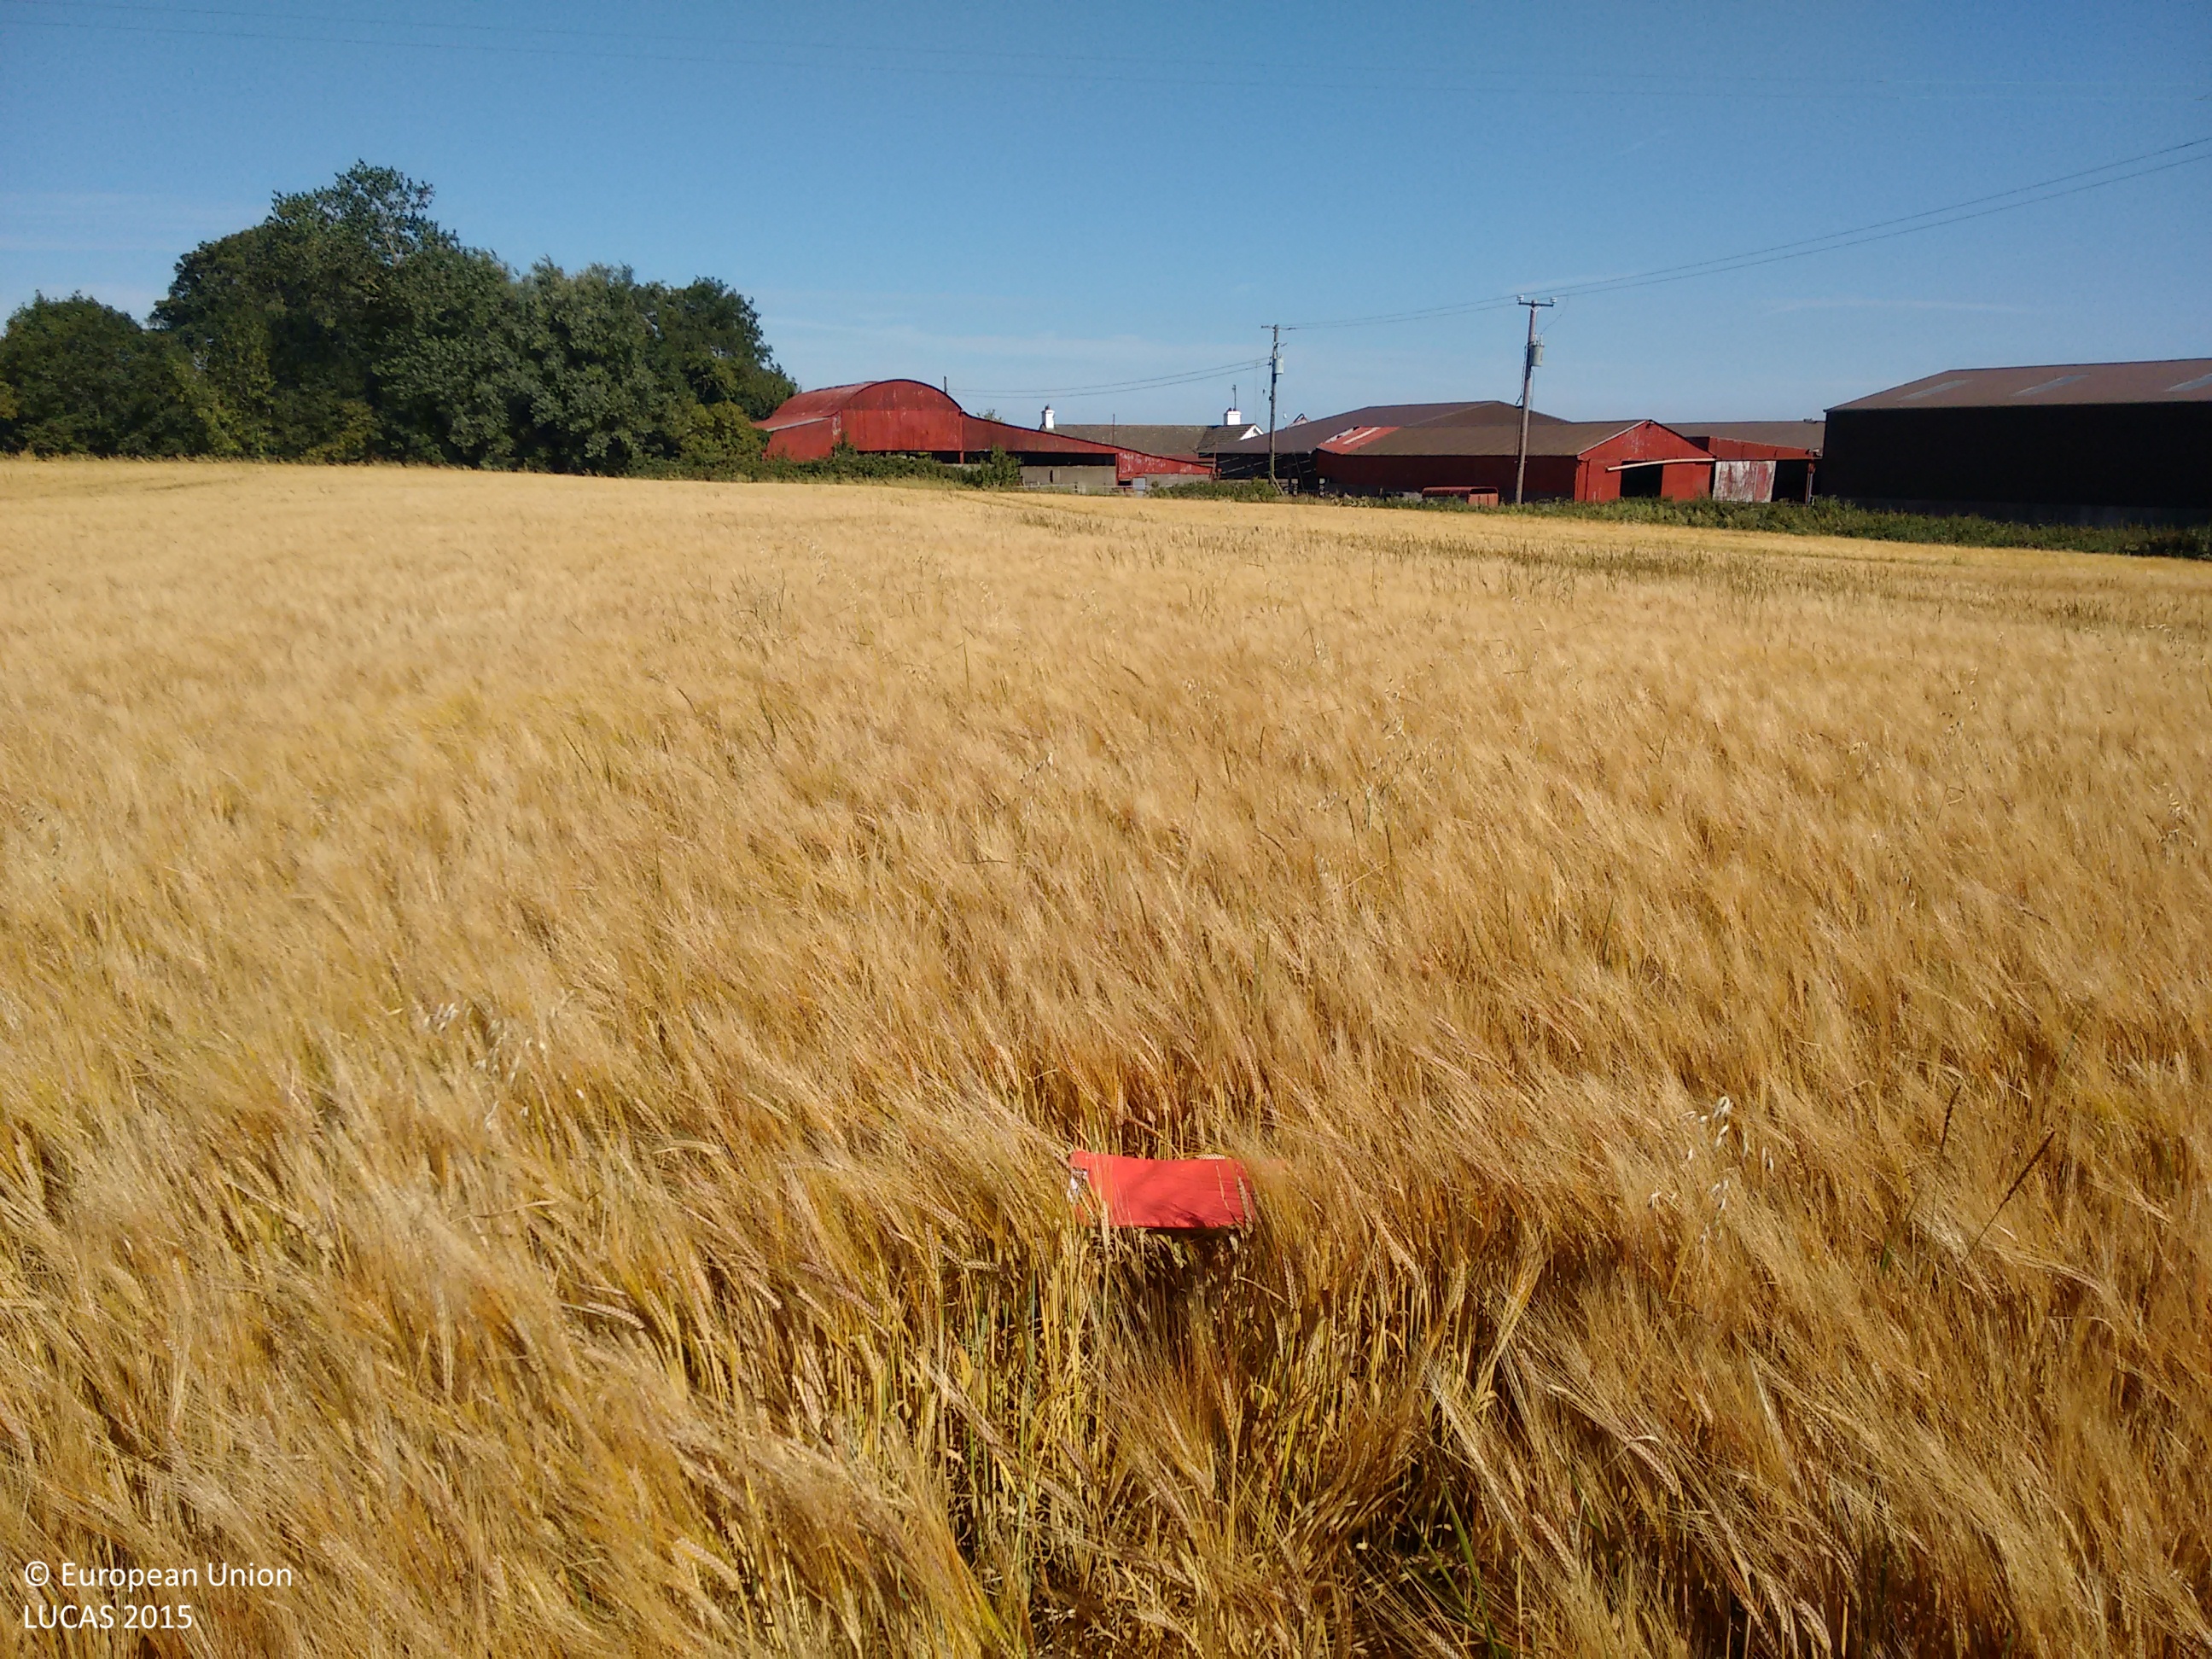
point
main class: Cropland
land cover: Barley
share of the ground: > 75 %
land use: Agriculture (excluding fallow land and kitchen gardens)
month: August
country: IE
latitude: 53.8644
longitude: -6.3152
